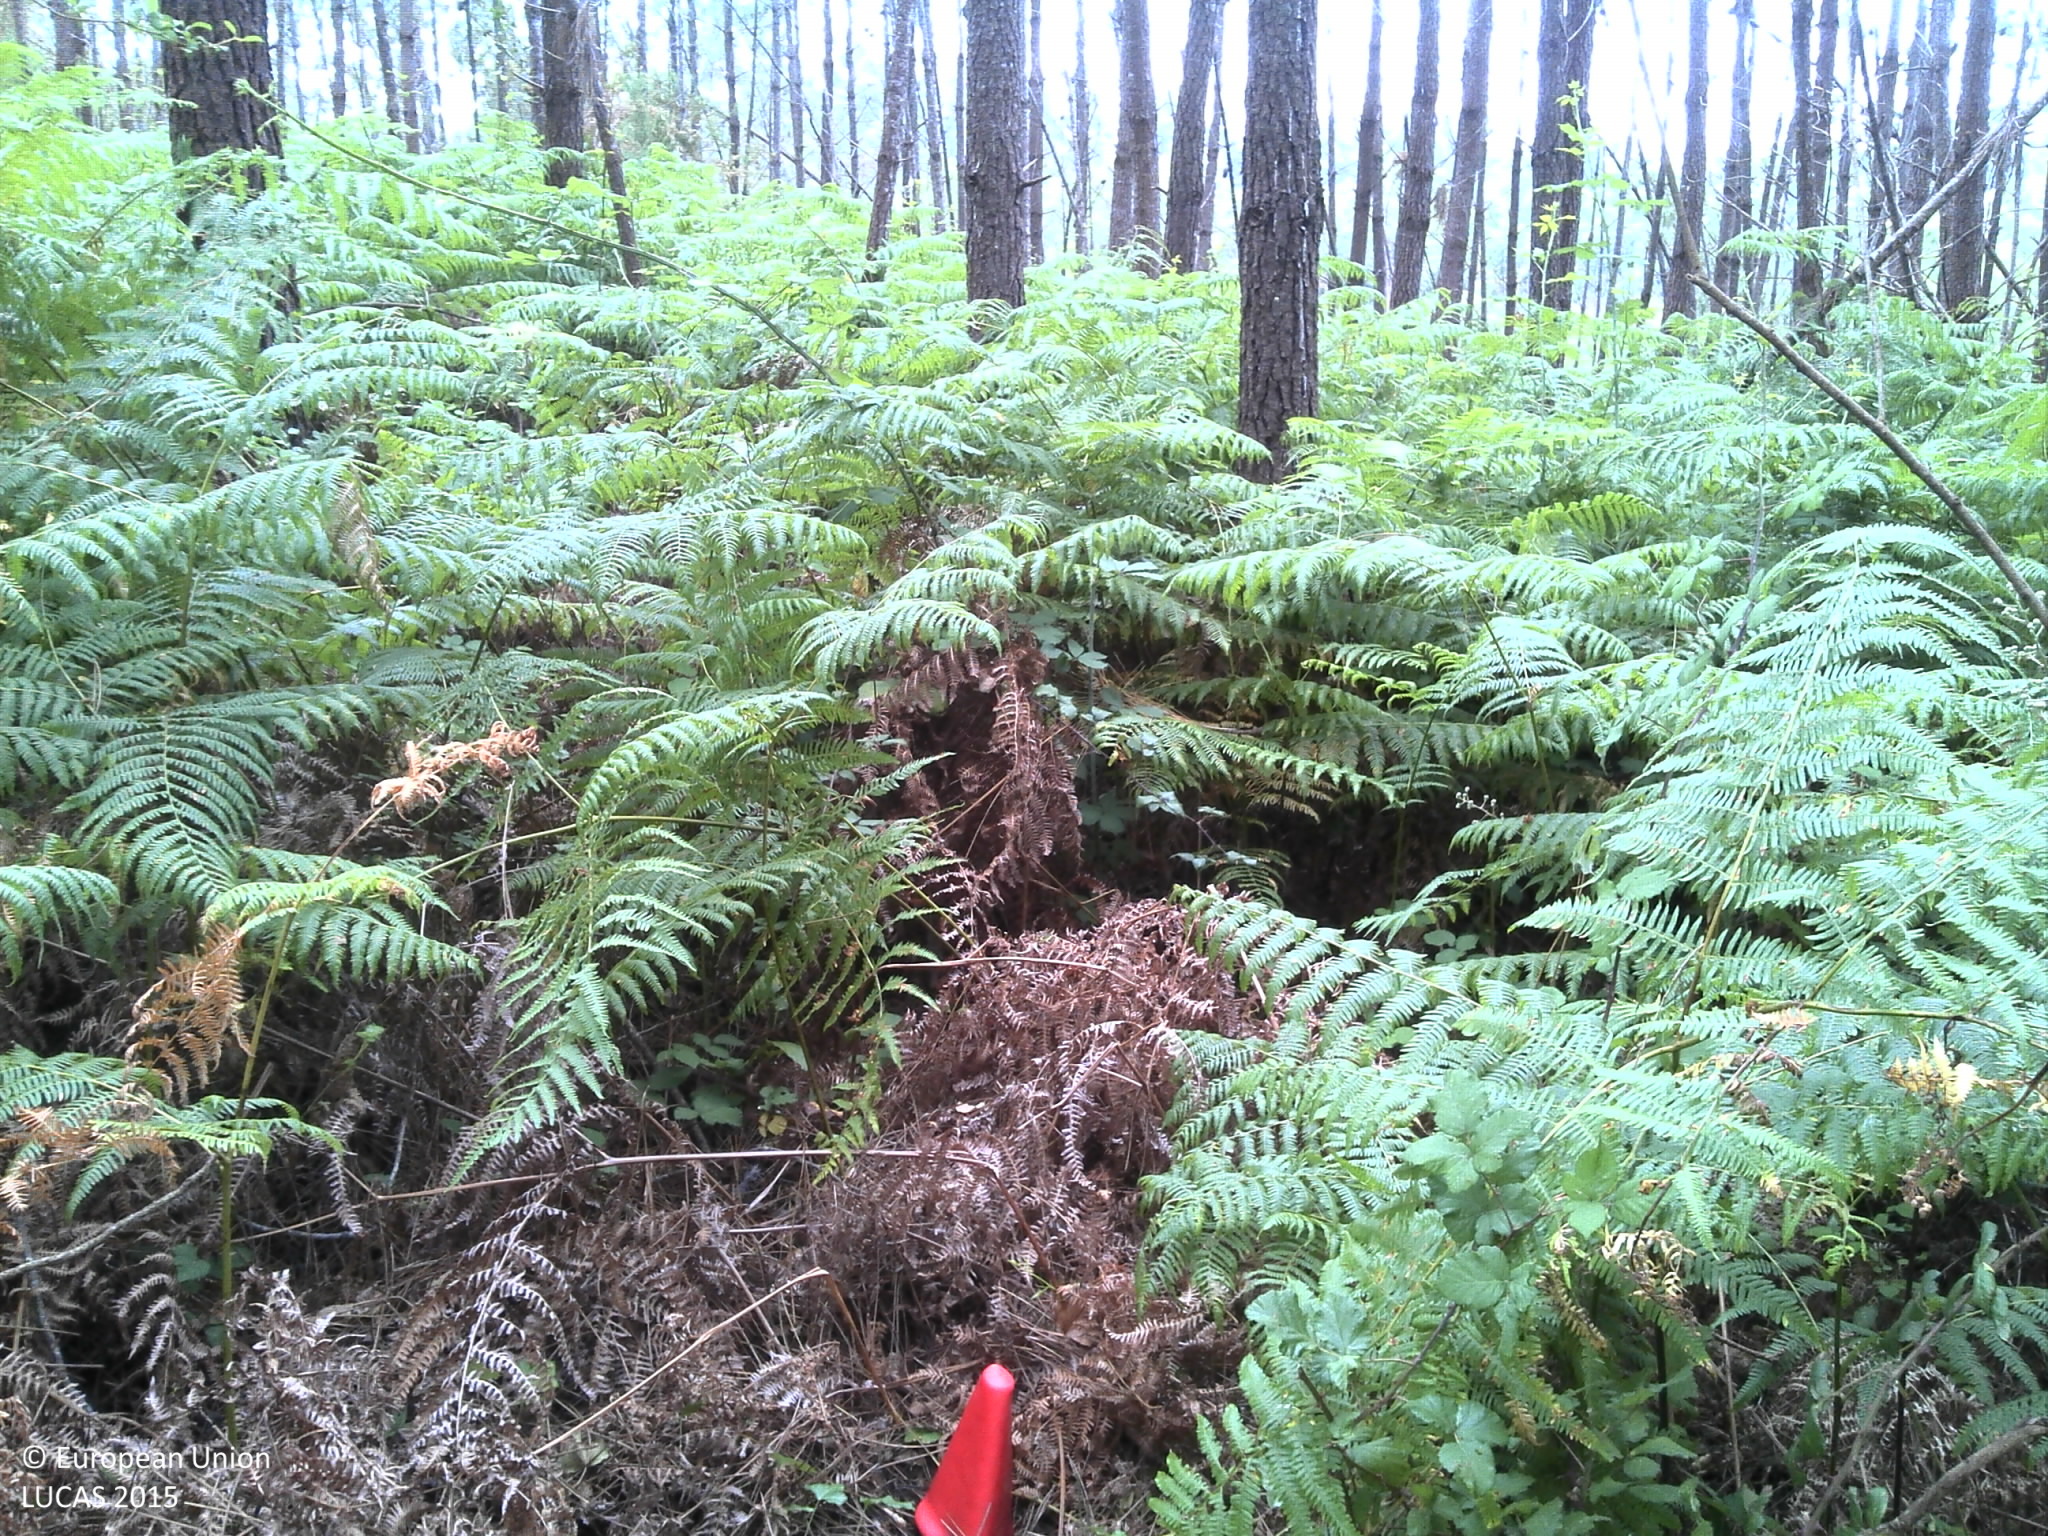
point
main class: Woodland
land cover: Pine dominated coniferous woodland
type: coniferous forest of the mediterranean region
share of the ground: 50 - 75 %
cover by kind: coniferous forest trees 60 %, shrubs 25 %, unconsolidated bare surface 15 %
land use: Forestry
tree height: > 5 m
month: June
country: PT
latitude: 40.2682
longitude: -8.6835
